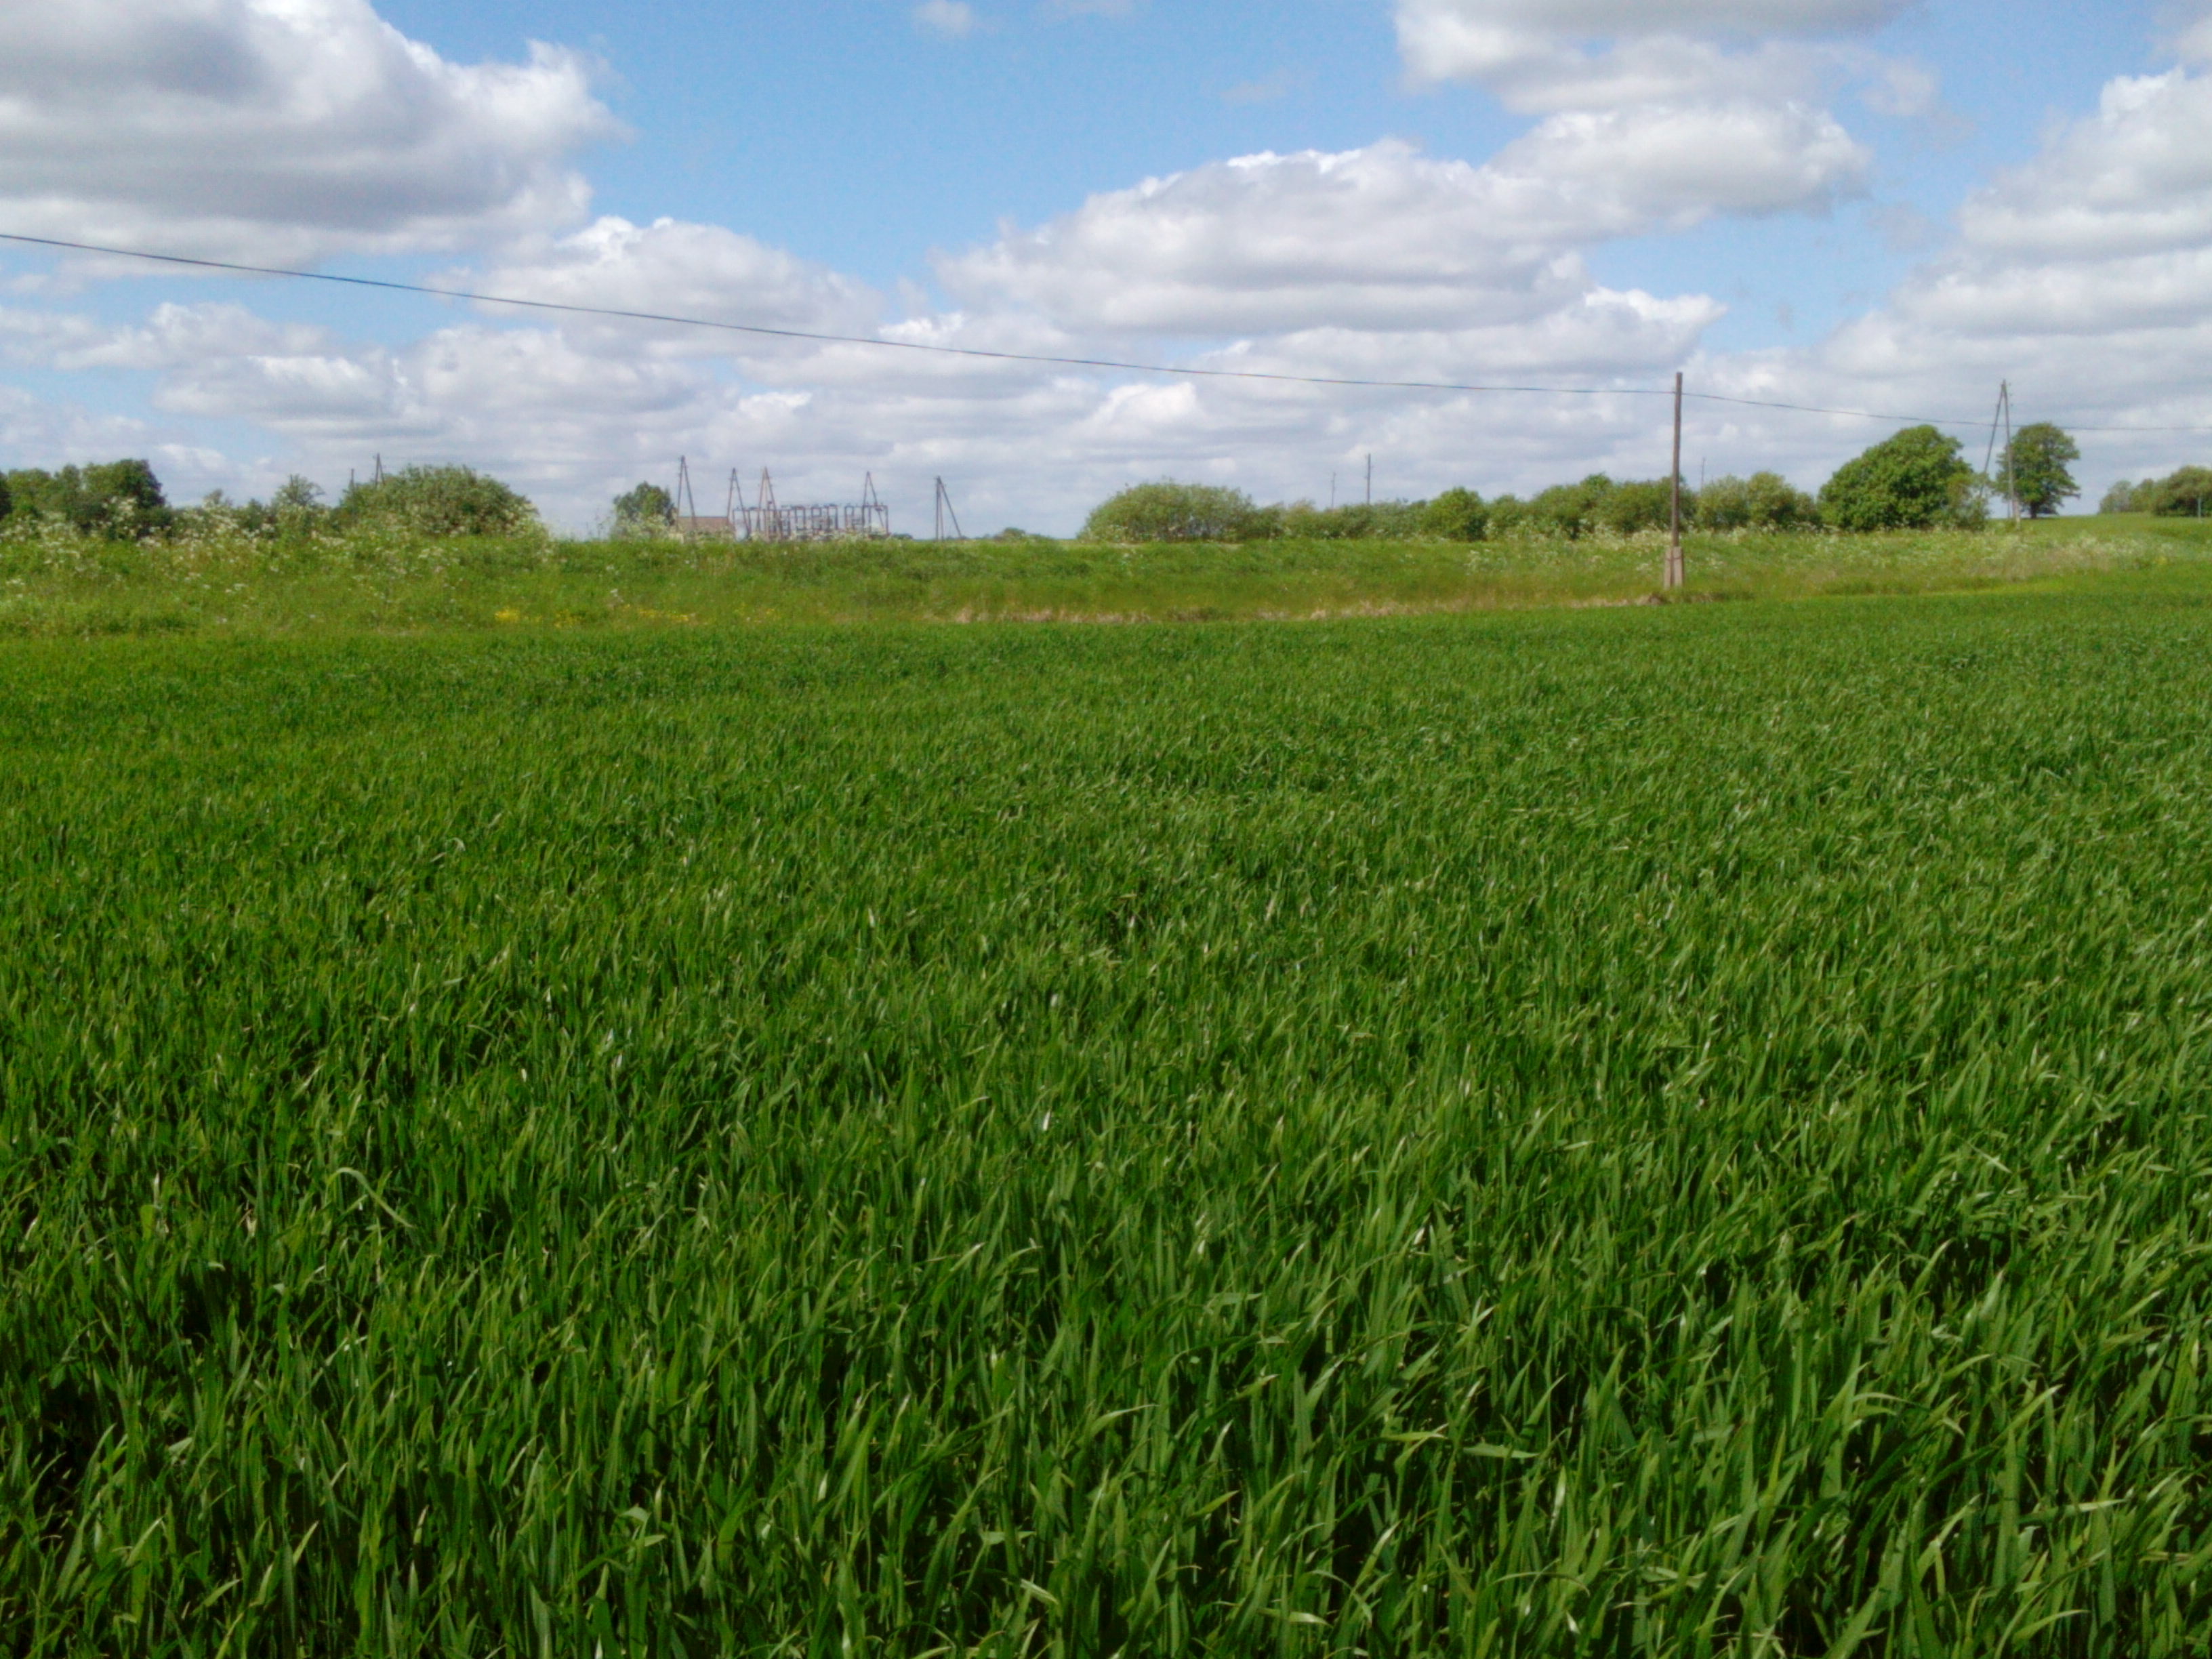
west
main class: Cropland
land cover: Barley
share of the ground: > 75 %
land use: Agriculture (excluding fallow land and kitchen gardens)
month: June
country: LV
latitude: 56.7524
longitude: 22.3688
